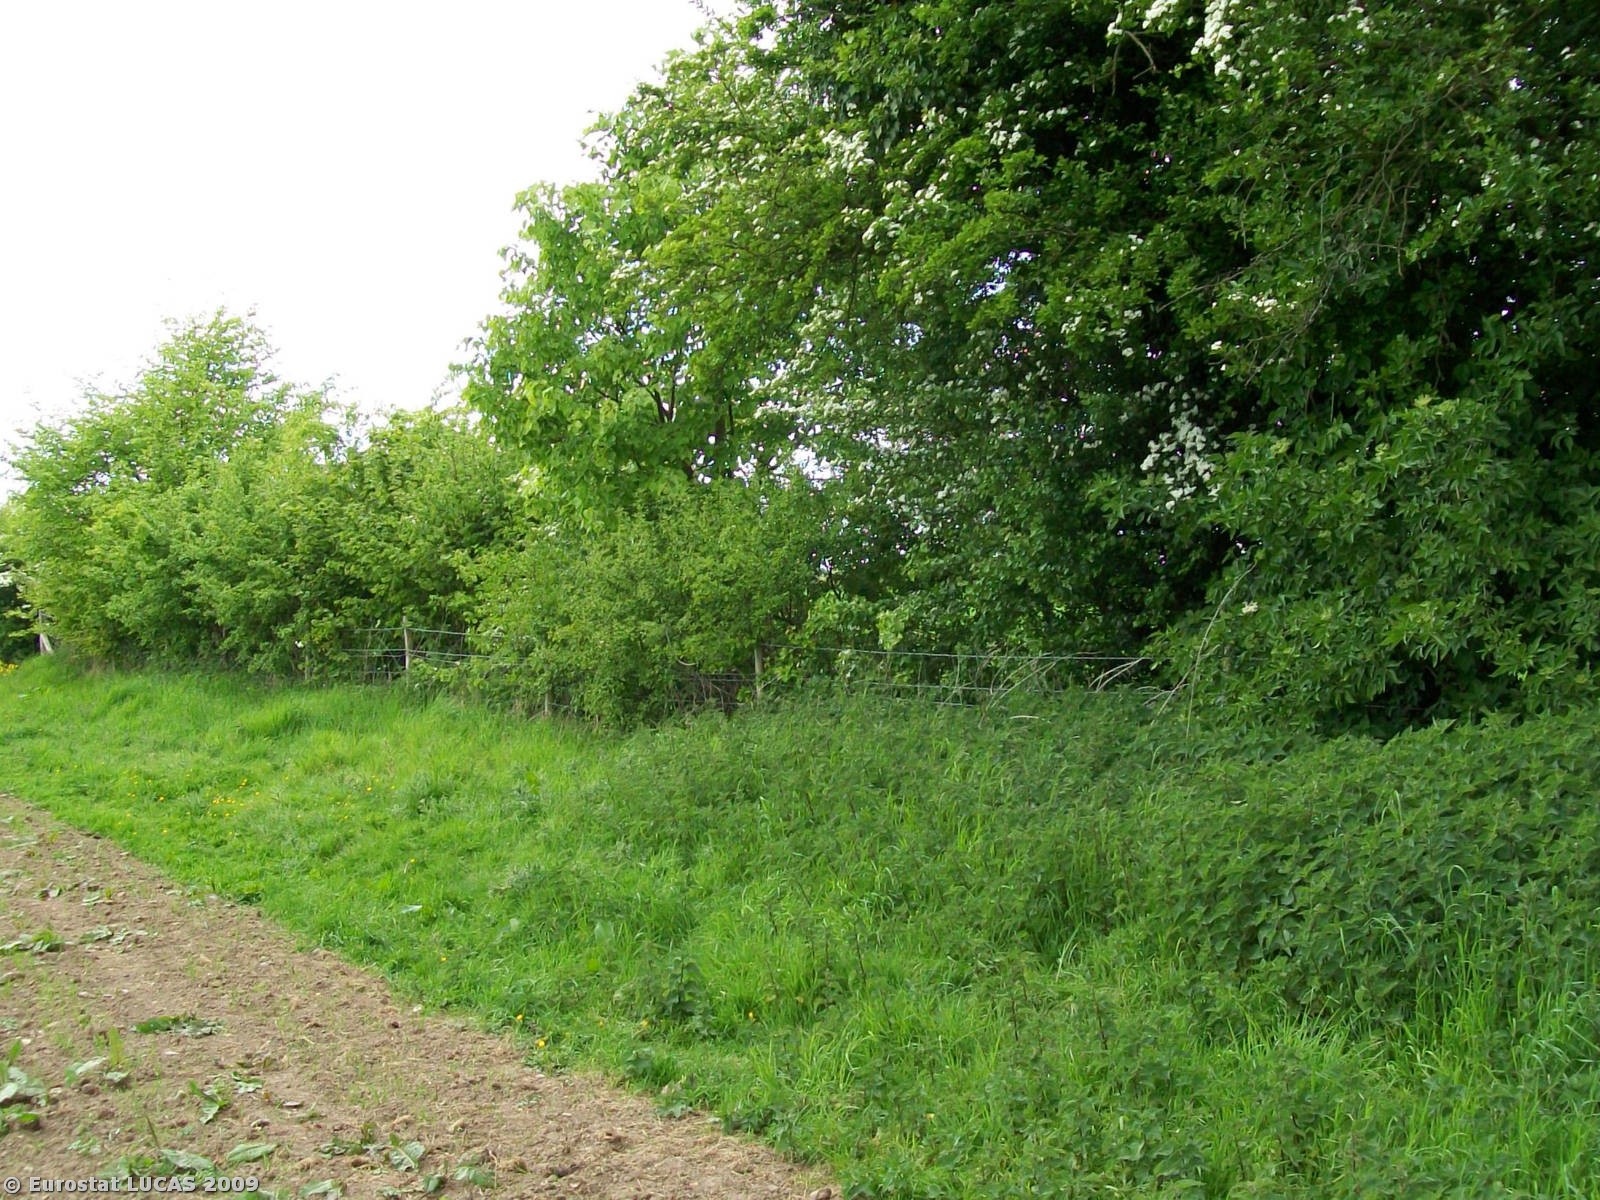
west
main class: Cropland
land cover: Barley
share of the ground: > 75 %
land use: Agriculture (excluding fallow land and kitchen gardens)
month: May
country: GB
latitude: 51.4868
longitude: -0.7706
